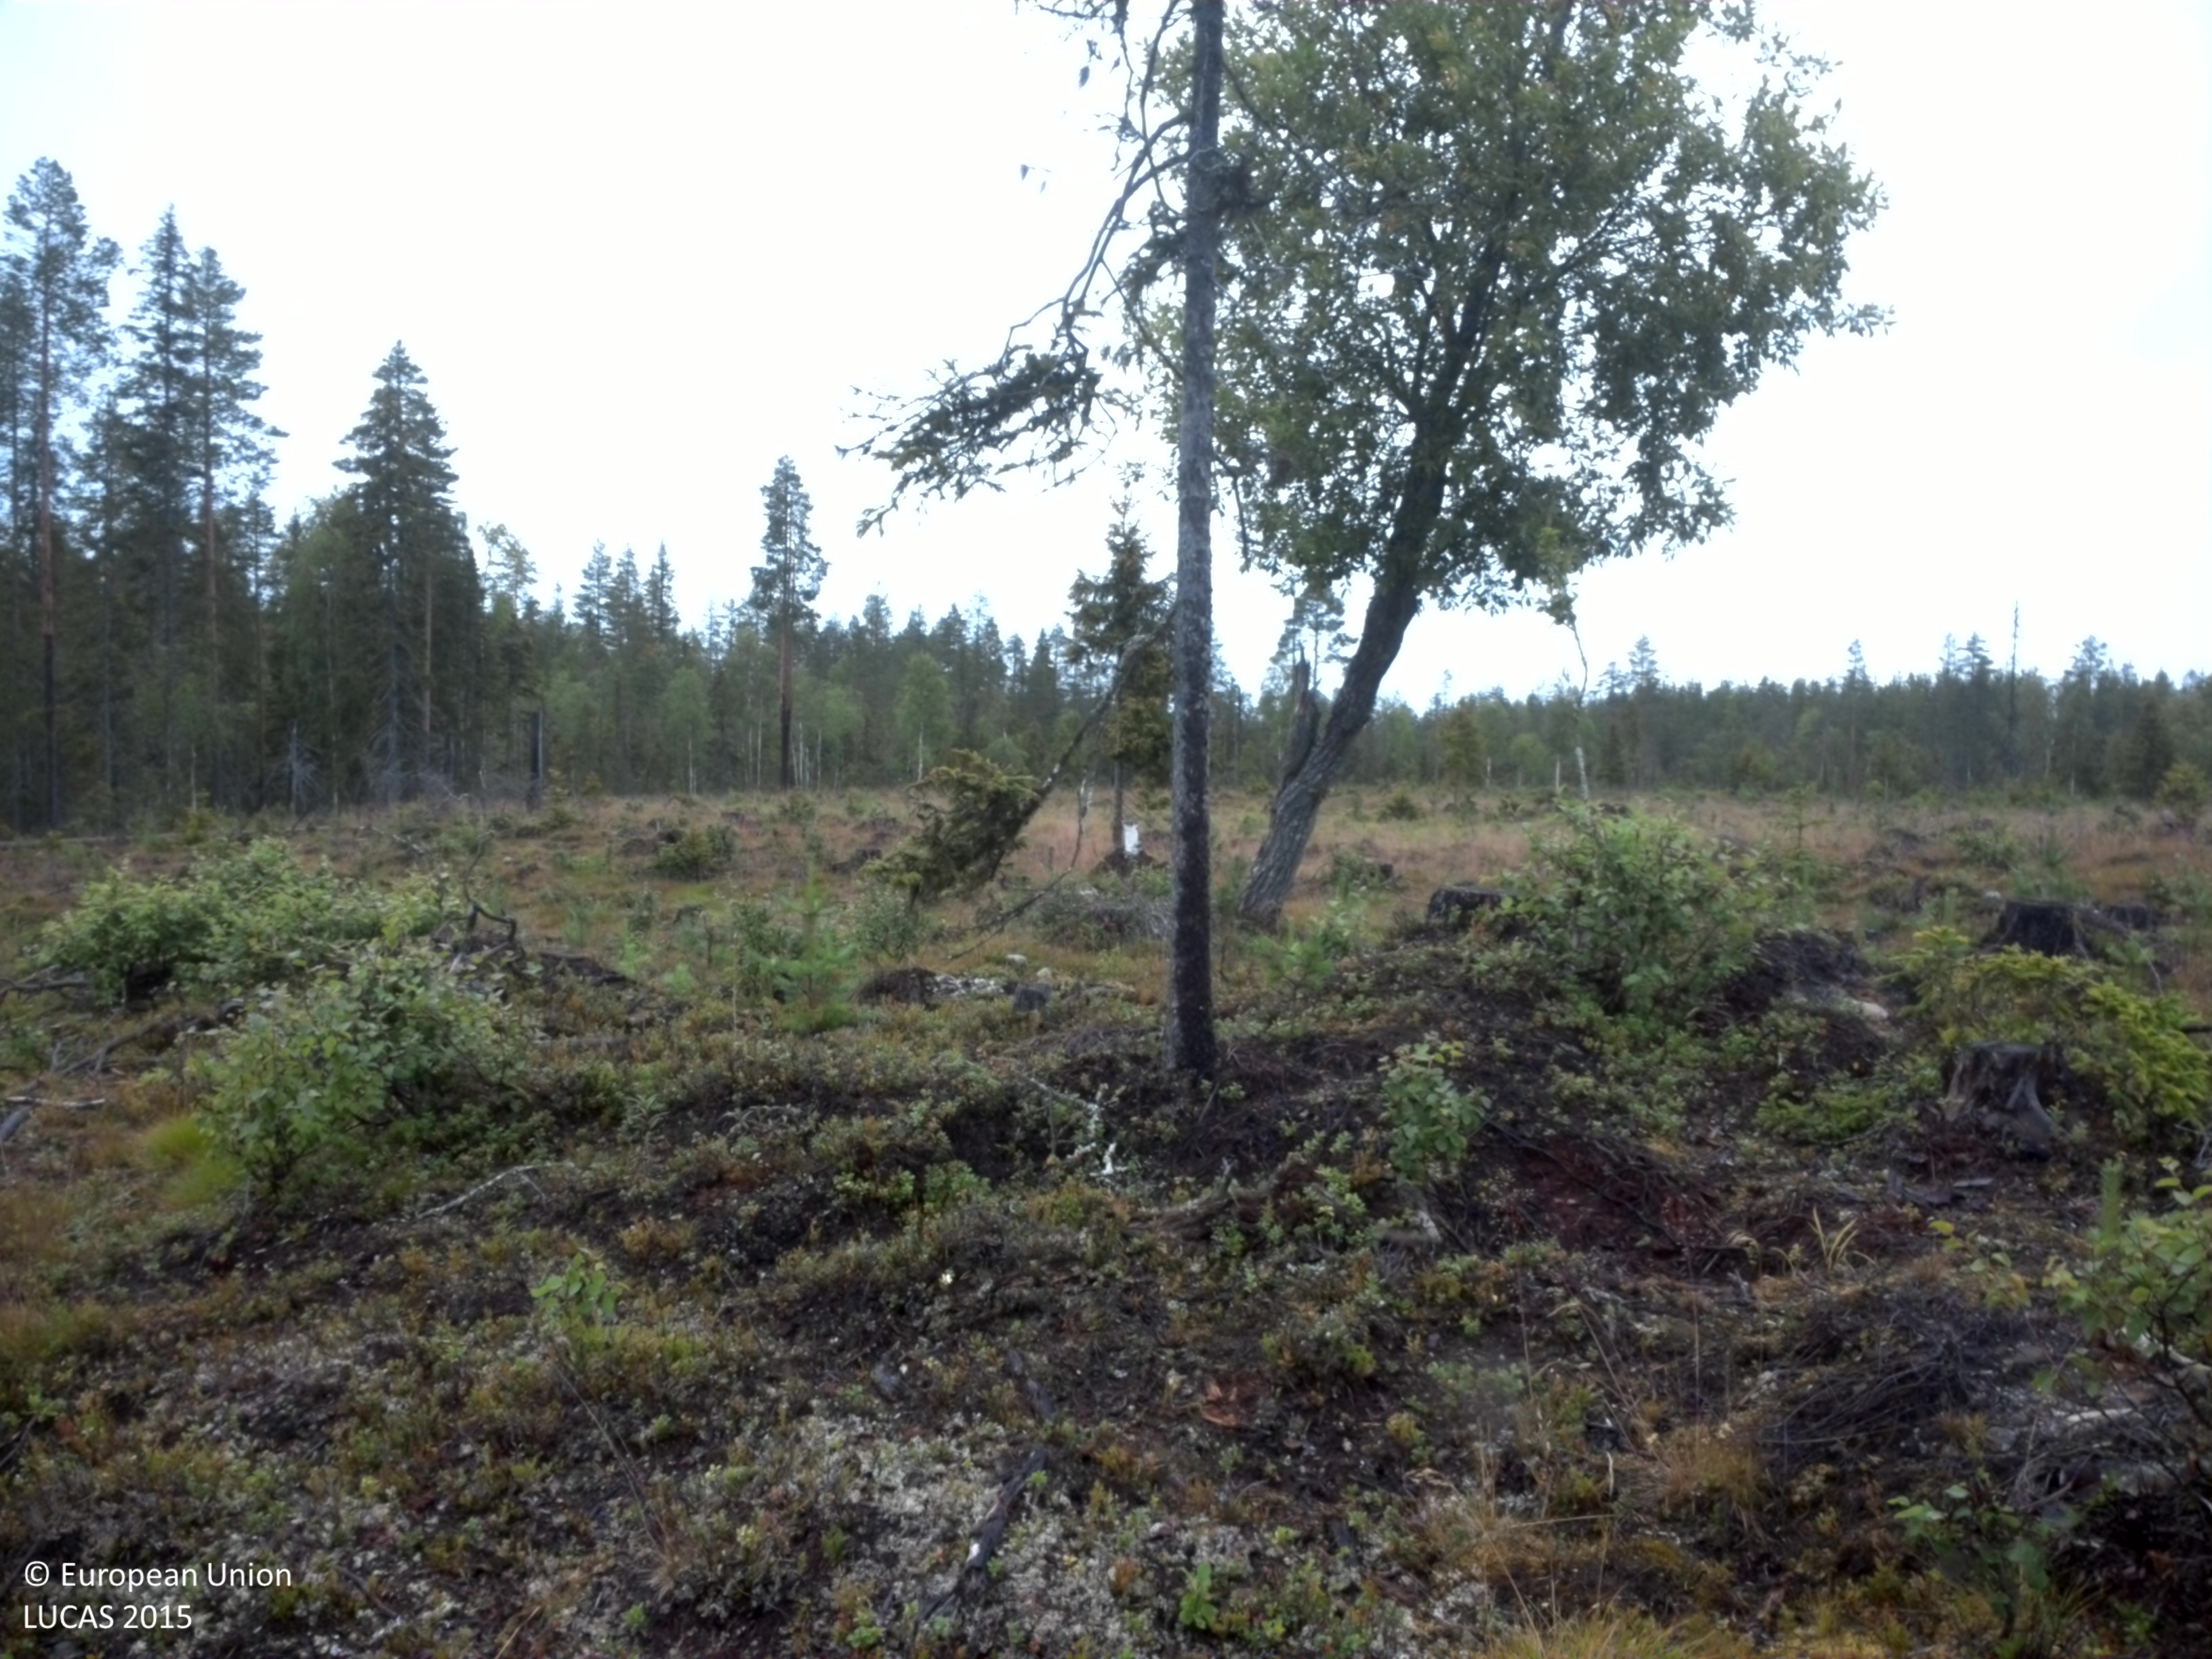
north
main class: Woodland
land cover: Other mixed woodland
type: boreal forest
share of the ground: 10 - 25 %
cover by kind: herbaceous plants 55 %, shrubs 15 %, coniferous forest trees 10 %, broadleaved forest trees 10 %, lichens and mosses 10 %
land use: Forestry
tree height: < 5 m
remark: Clear cut
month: August
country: SE
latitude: 64.6446
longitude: 20.0398
